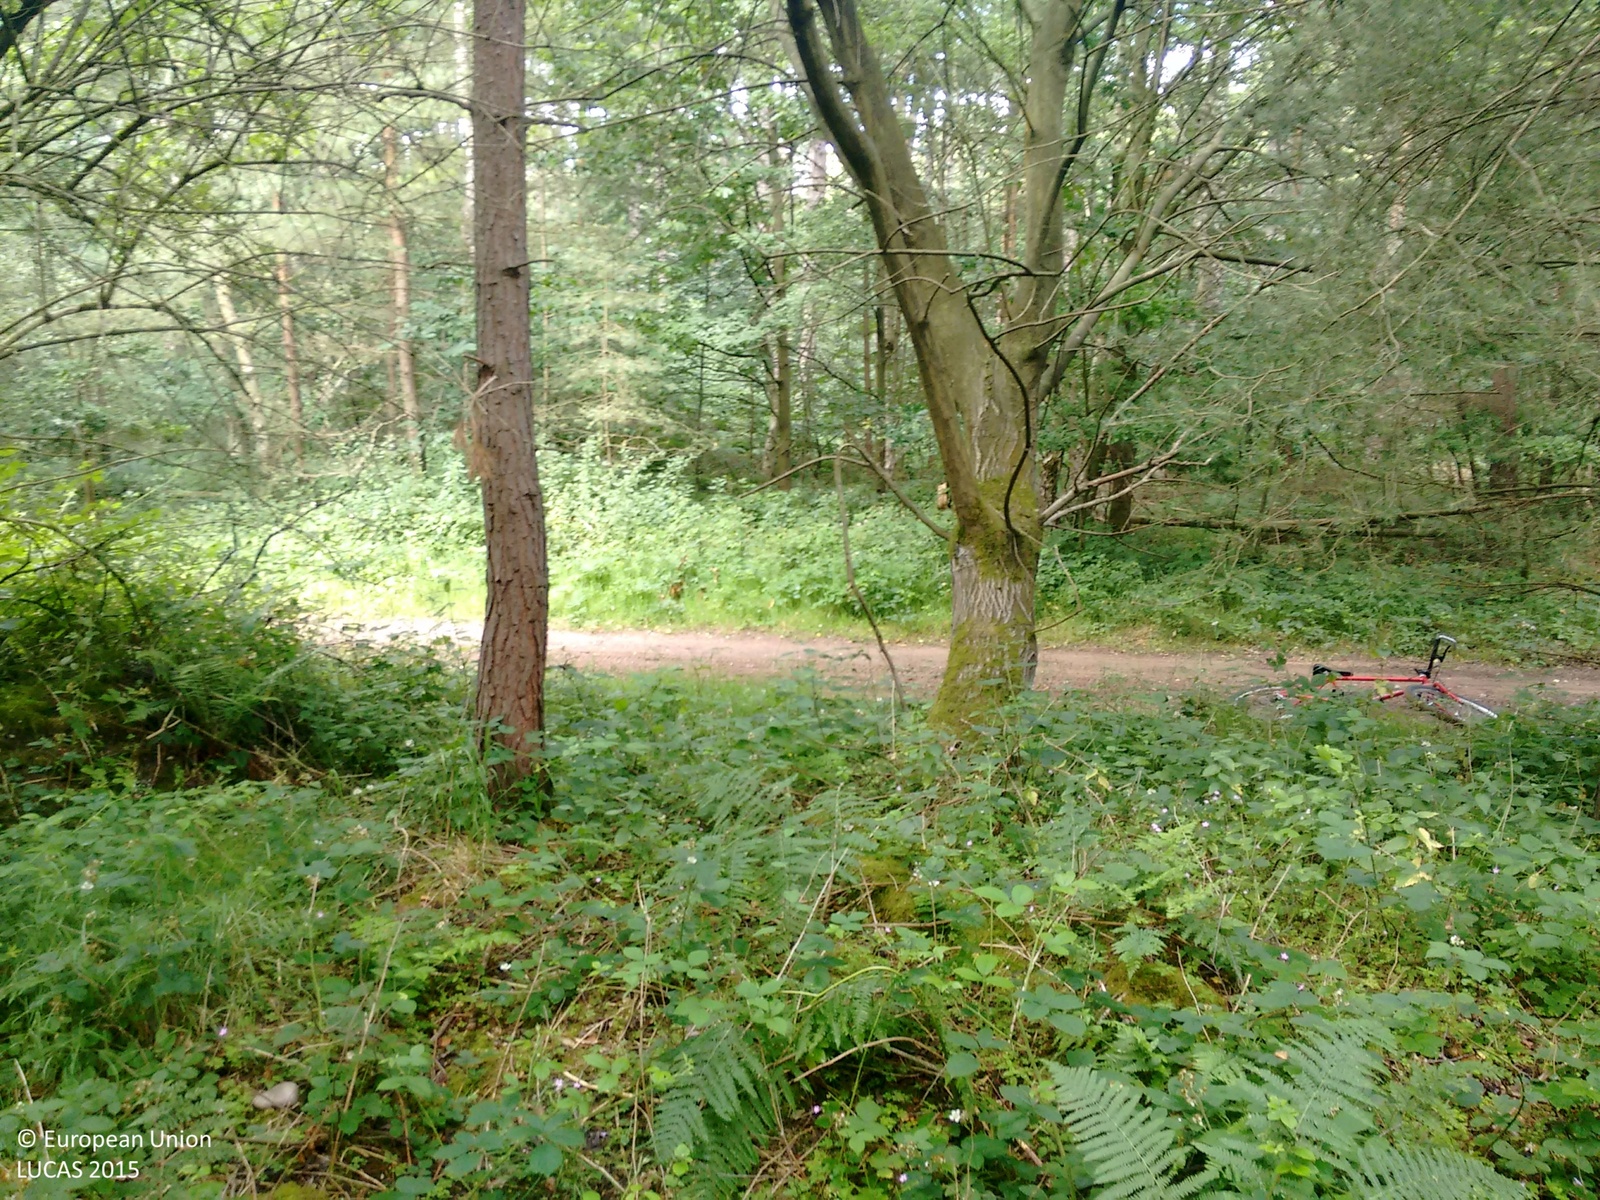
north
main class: Woodland
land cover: Spruce dominated coniferous woodland
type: exotic forest
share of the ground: > 75 %
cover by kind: coniferous forest trees 80 %, broadleaved forest trees 20 %
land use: Forestry
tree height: > 5 m
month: July
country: GB
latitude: 53.1446
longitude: -1.0935
